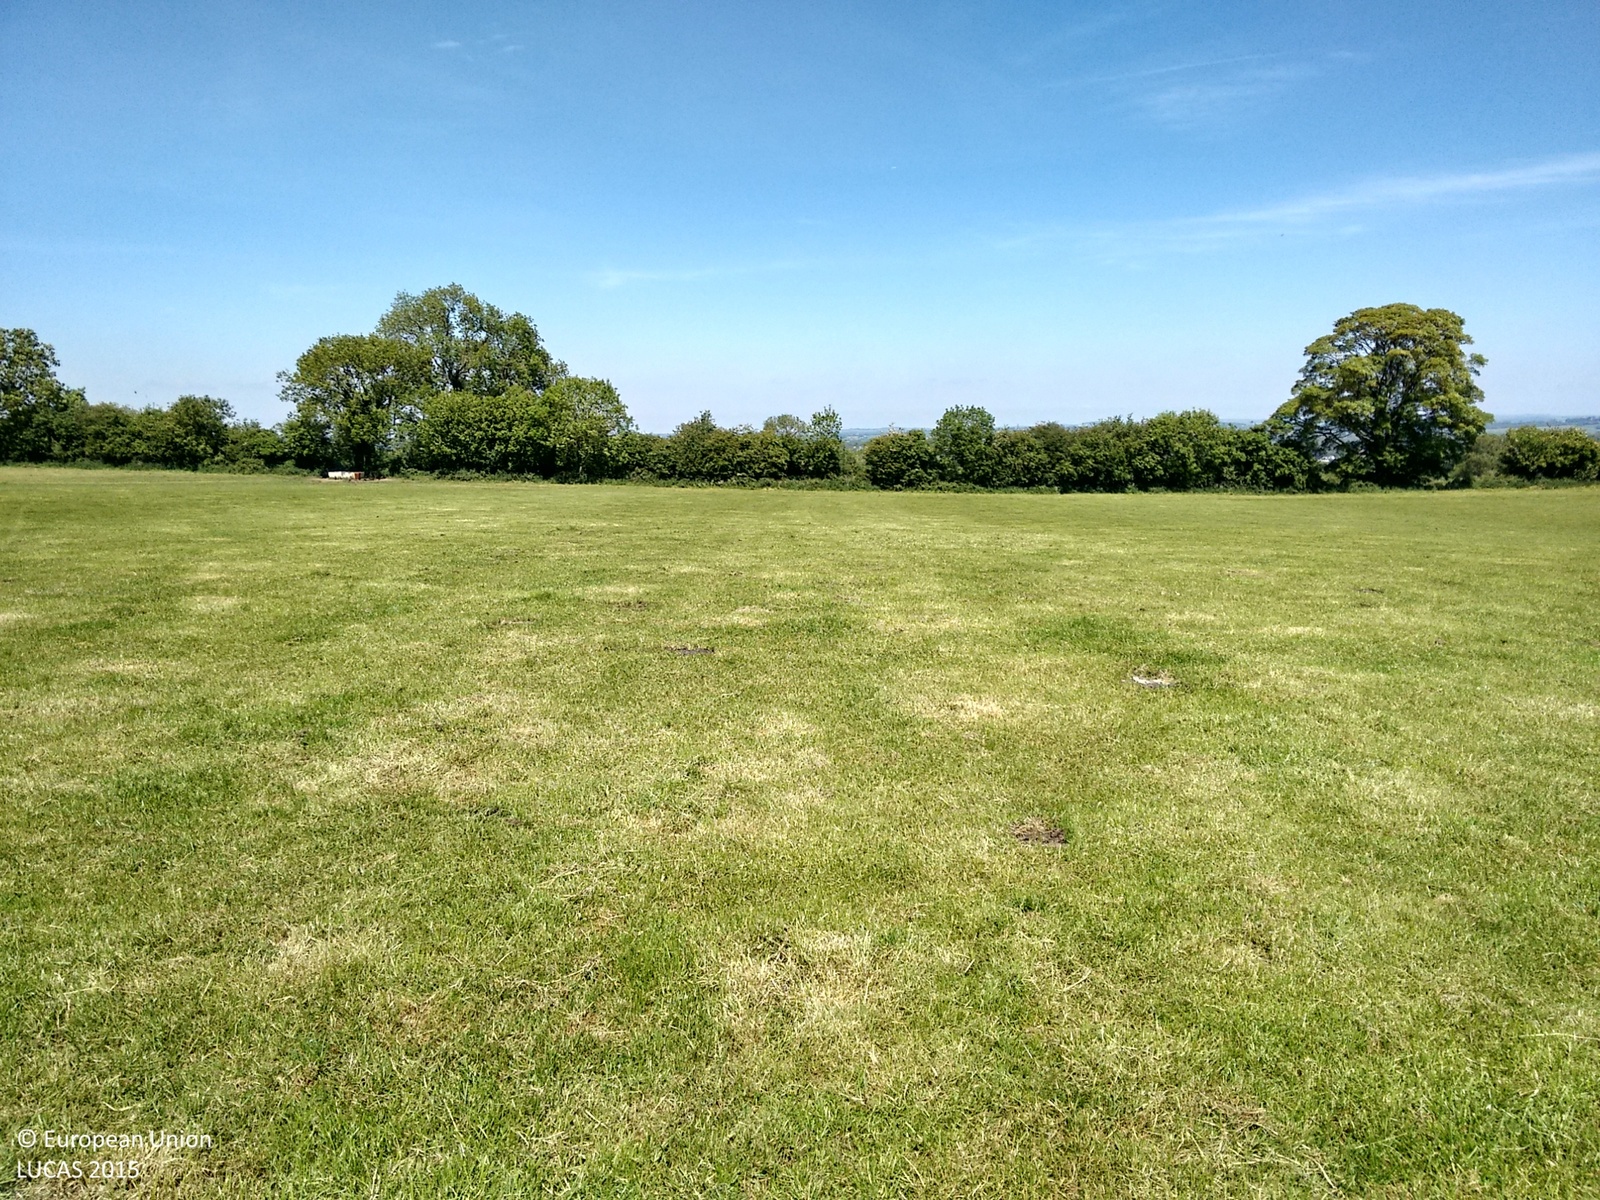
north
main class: Grassland
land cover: Grassland without tree/shrub cover
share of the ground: > 75 %
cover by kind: herbaceous plants 90 %, unconsolidated bare surface 10 %
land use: Agriculture (excluding fallow land and kitchen gardens)
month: June
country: IE
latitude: 53.5850
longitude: -6.6101
